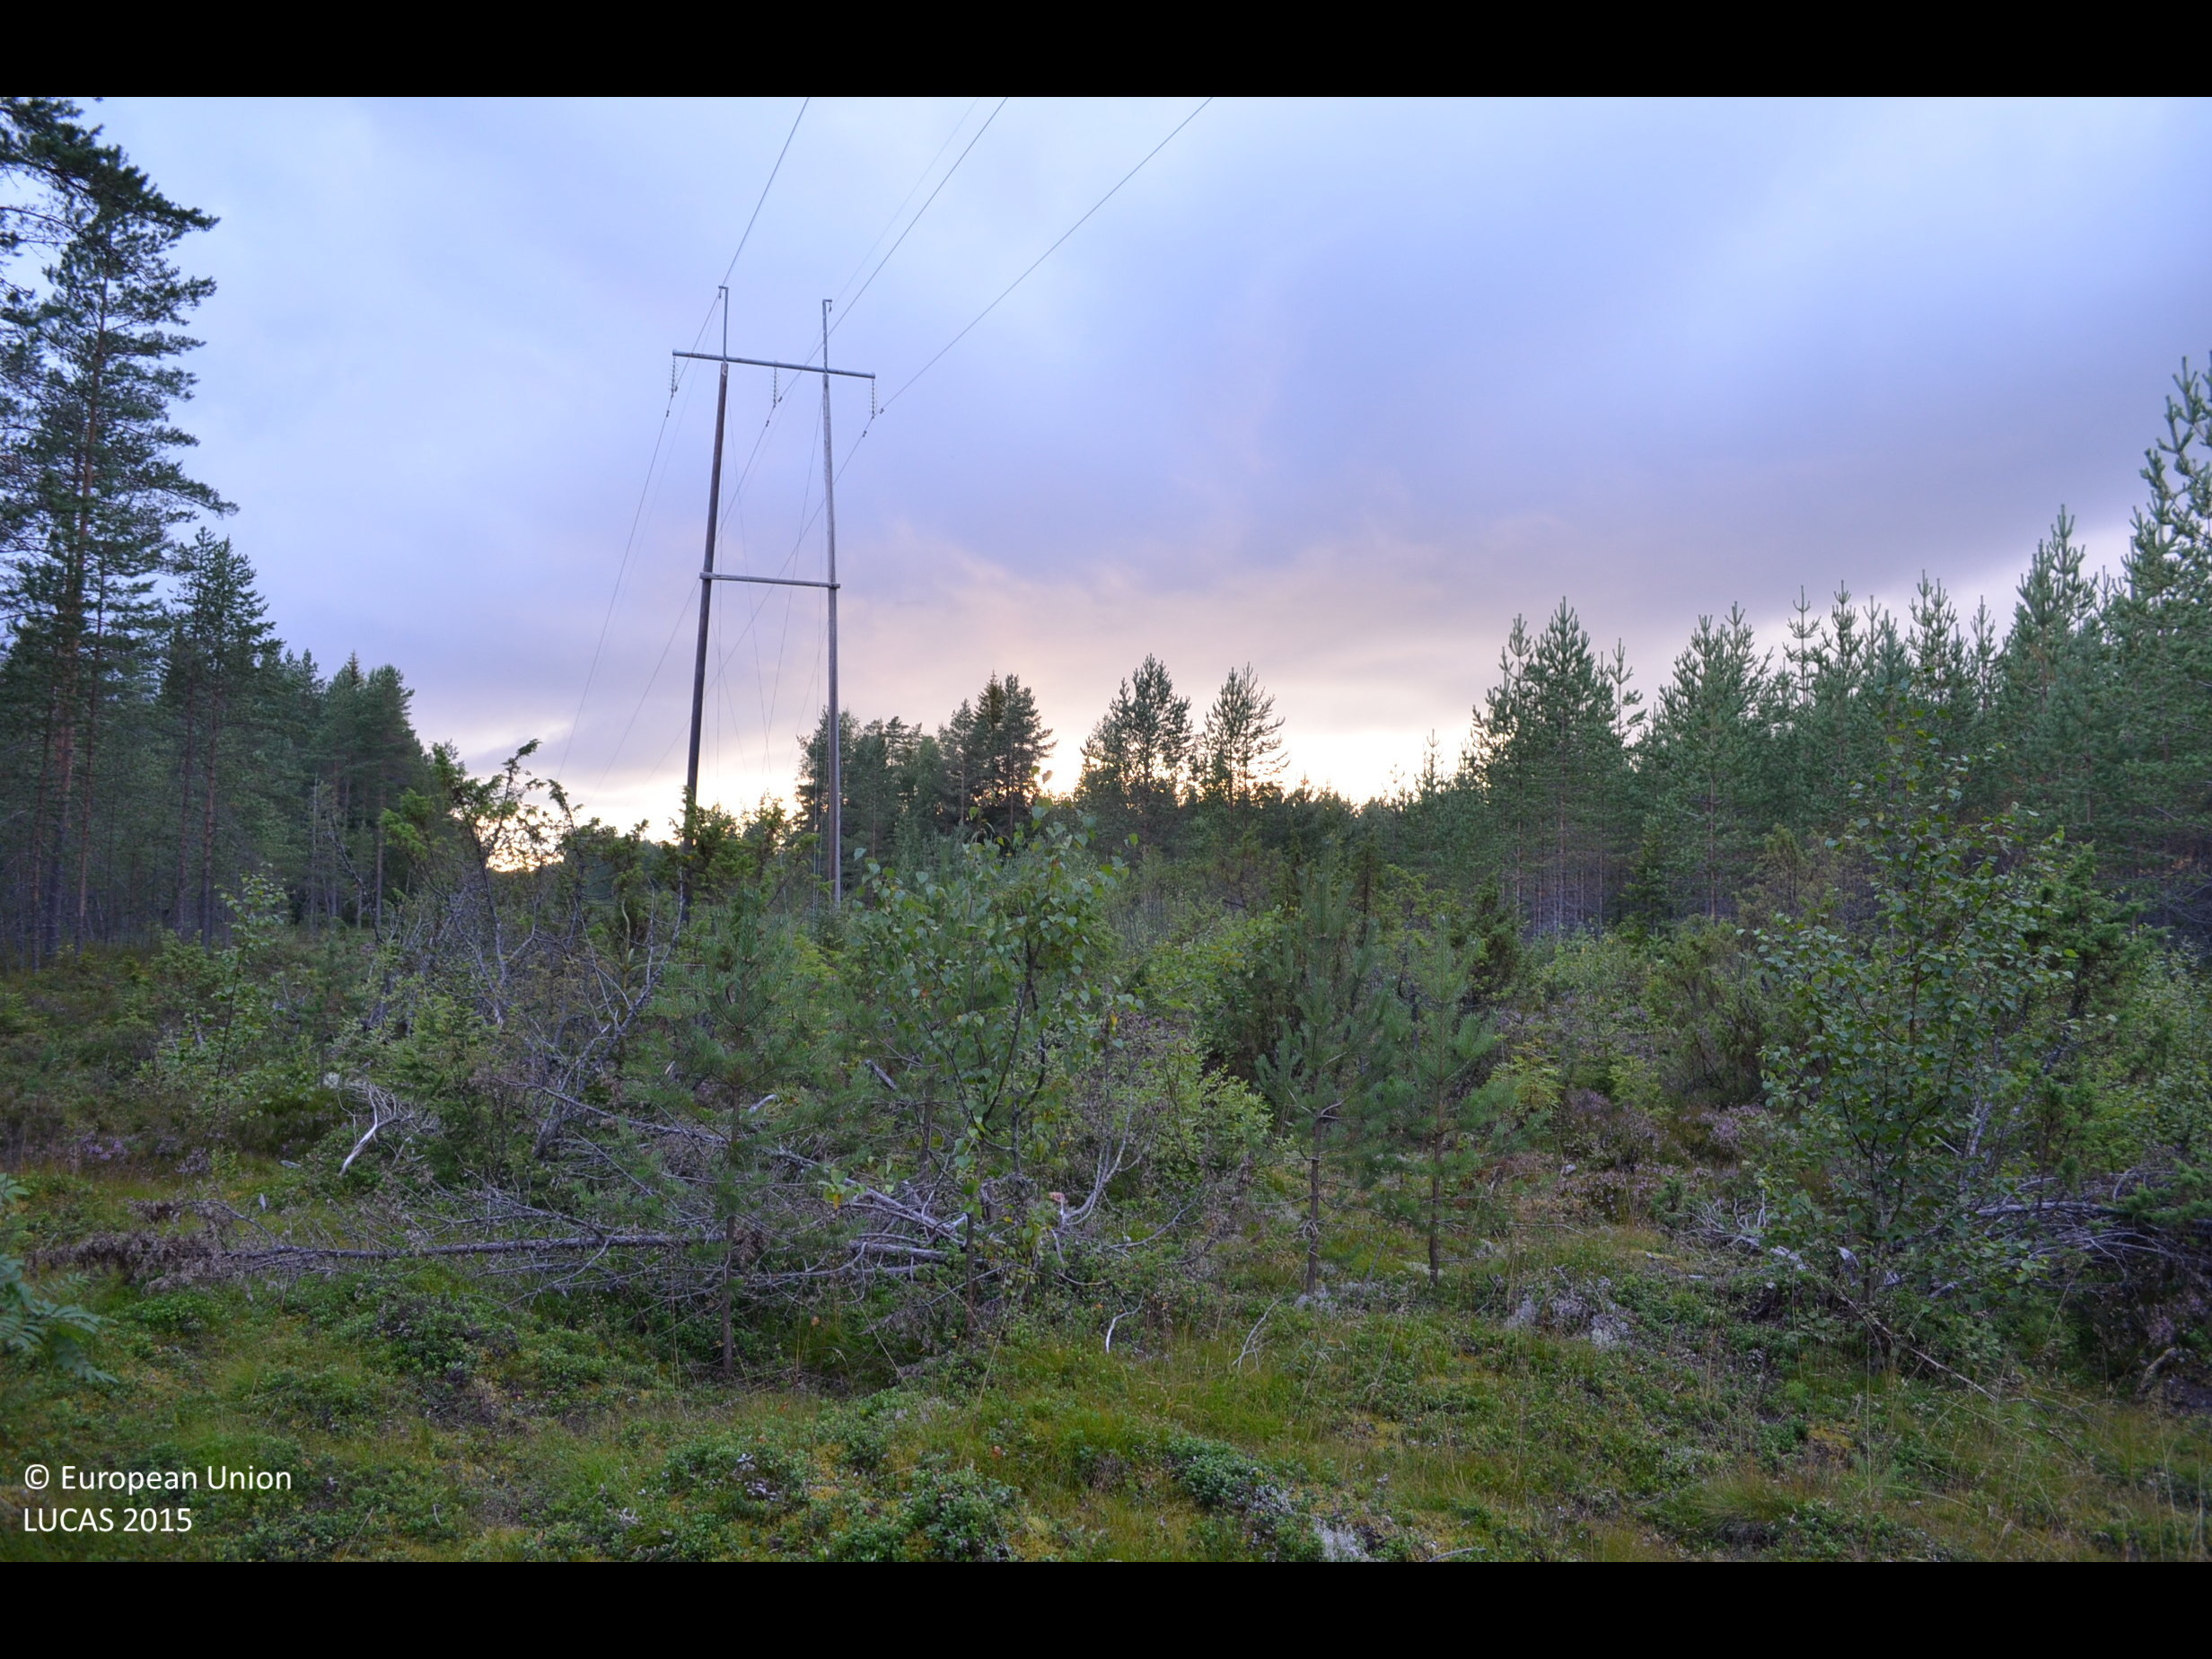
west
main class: Artificial land
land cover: Other artificial areas
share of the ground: < 10 %
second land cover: Other mixed woodland
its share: 25 - 50 %
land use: Electricity, gas and thermal power distribution
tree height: < 5 m
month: August
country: FI
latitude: 62.2753
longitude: 24.2879
